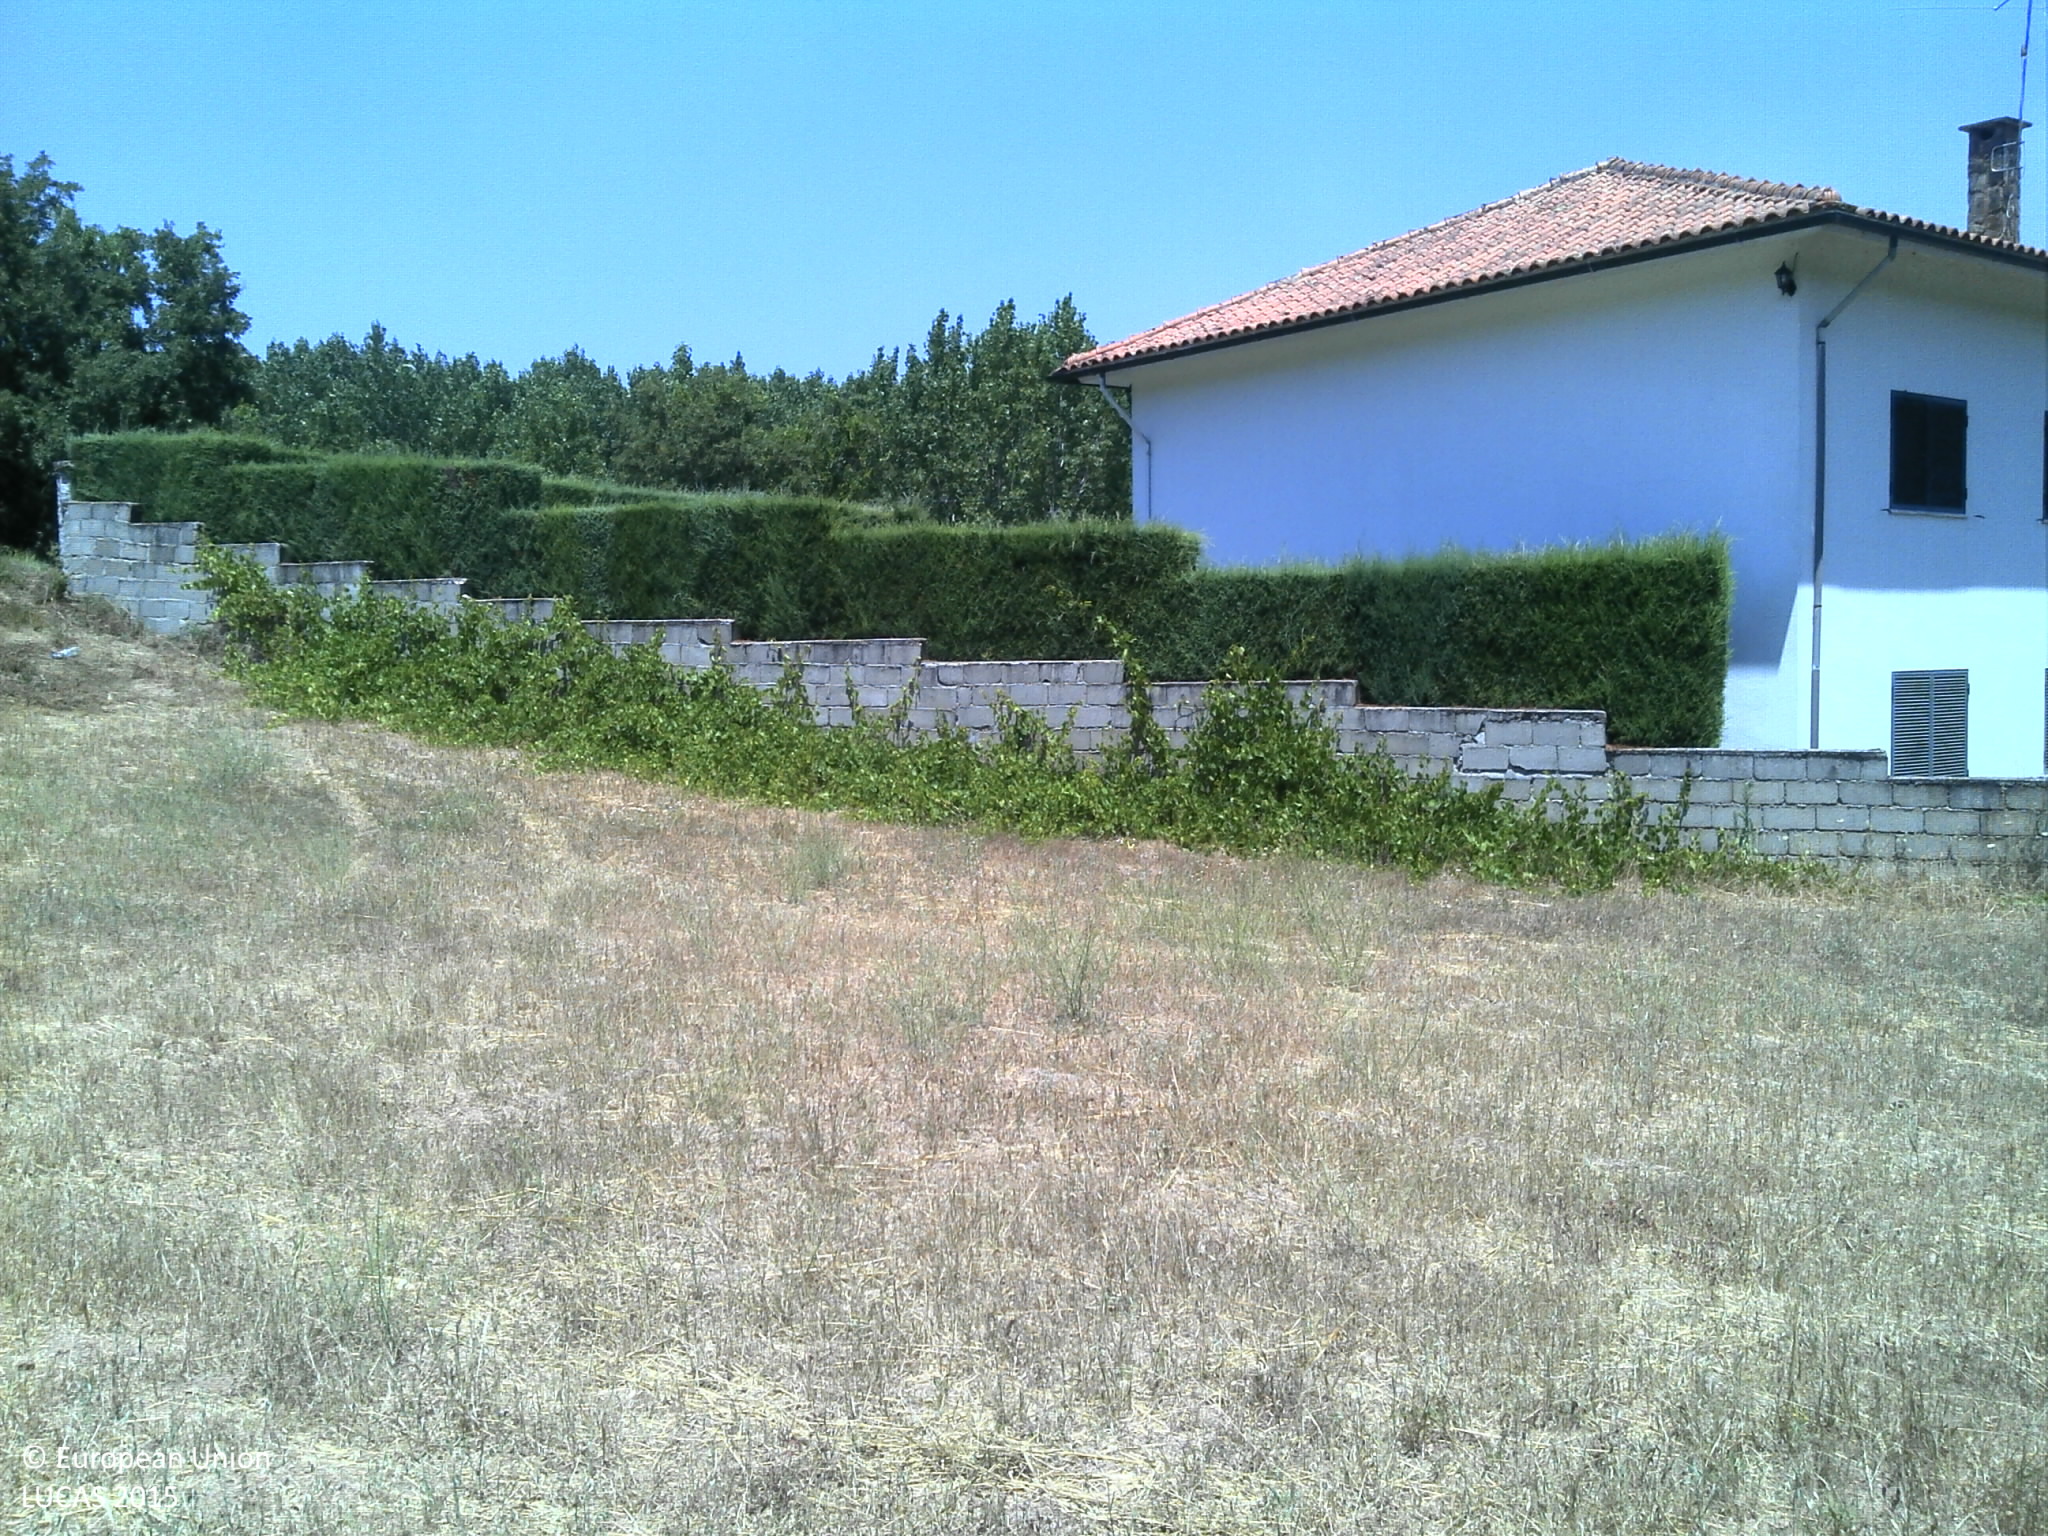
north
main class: Cropland
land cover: Other leguminous and mixtures for fodder
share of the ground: < 10 %
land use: Agriculture (excluding fallow land and kitchen gardens)
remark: Harvested field
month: July
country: PT
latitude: 40.3768
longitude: -8.0134
